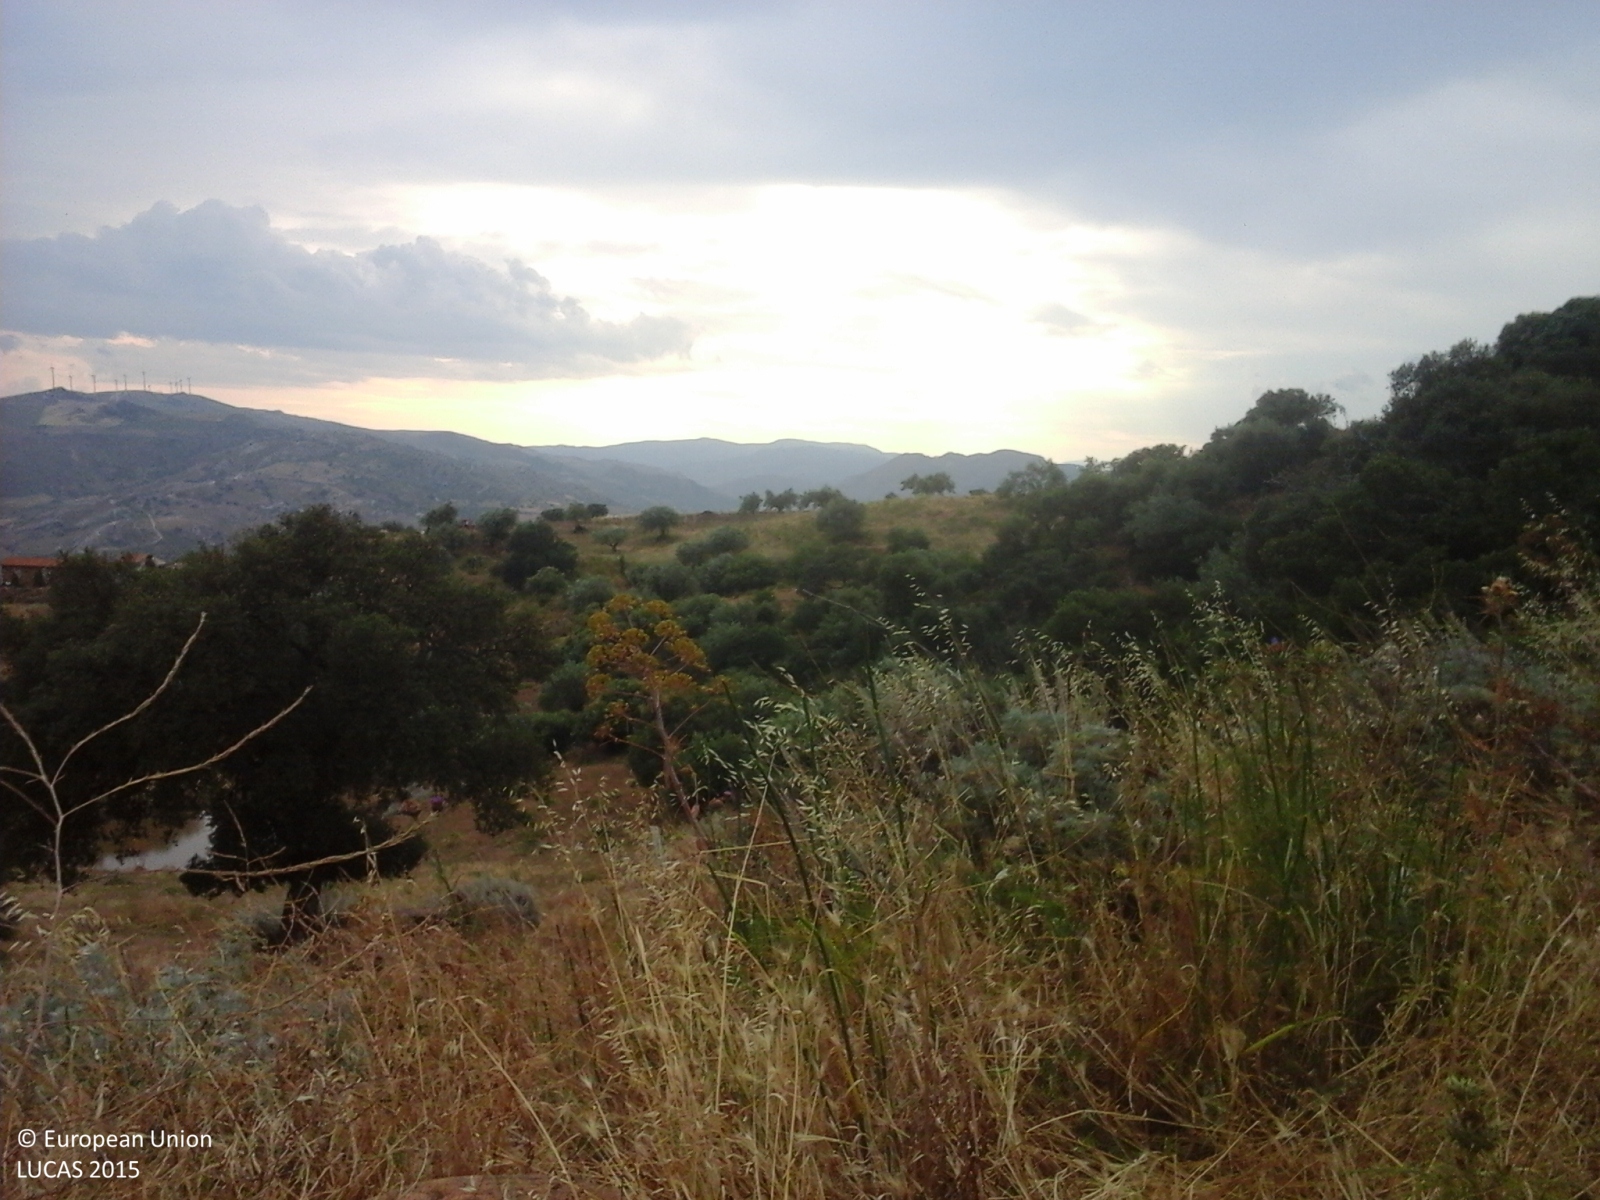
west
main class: Grassland
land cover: Grassland with sparse tree/shrub cover
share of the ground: > 75 %
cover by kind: herbaceous plants 75 %, unconsolidated bare surface 15 %, broadleaved forest trees 5 %, shrubs 5 %
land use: Agriculture (excluding fallow land and kitchen gardens)
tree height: < 5 m
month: June
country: IT
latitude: 37.7150
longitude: 14.4718
